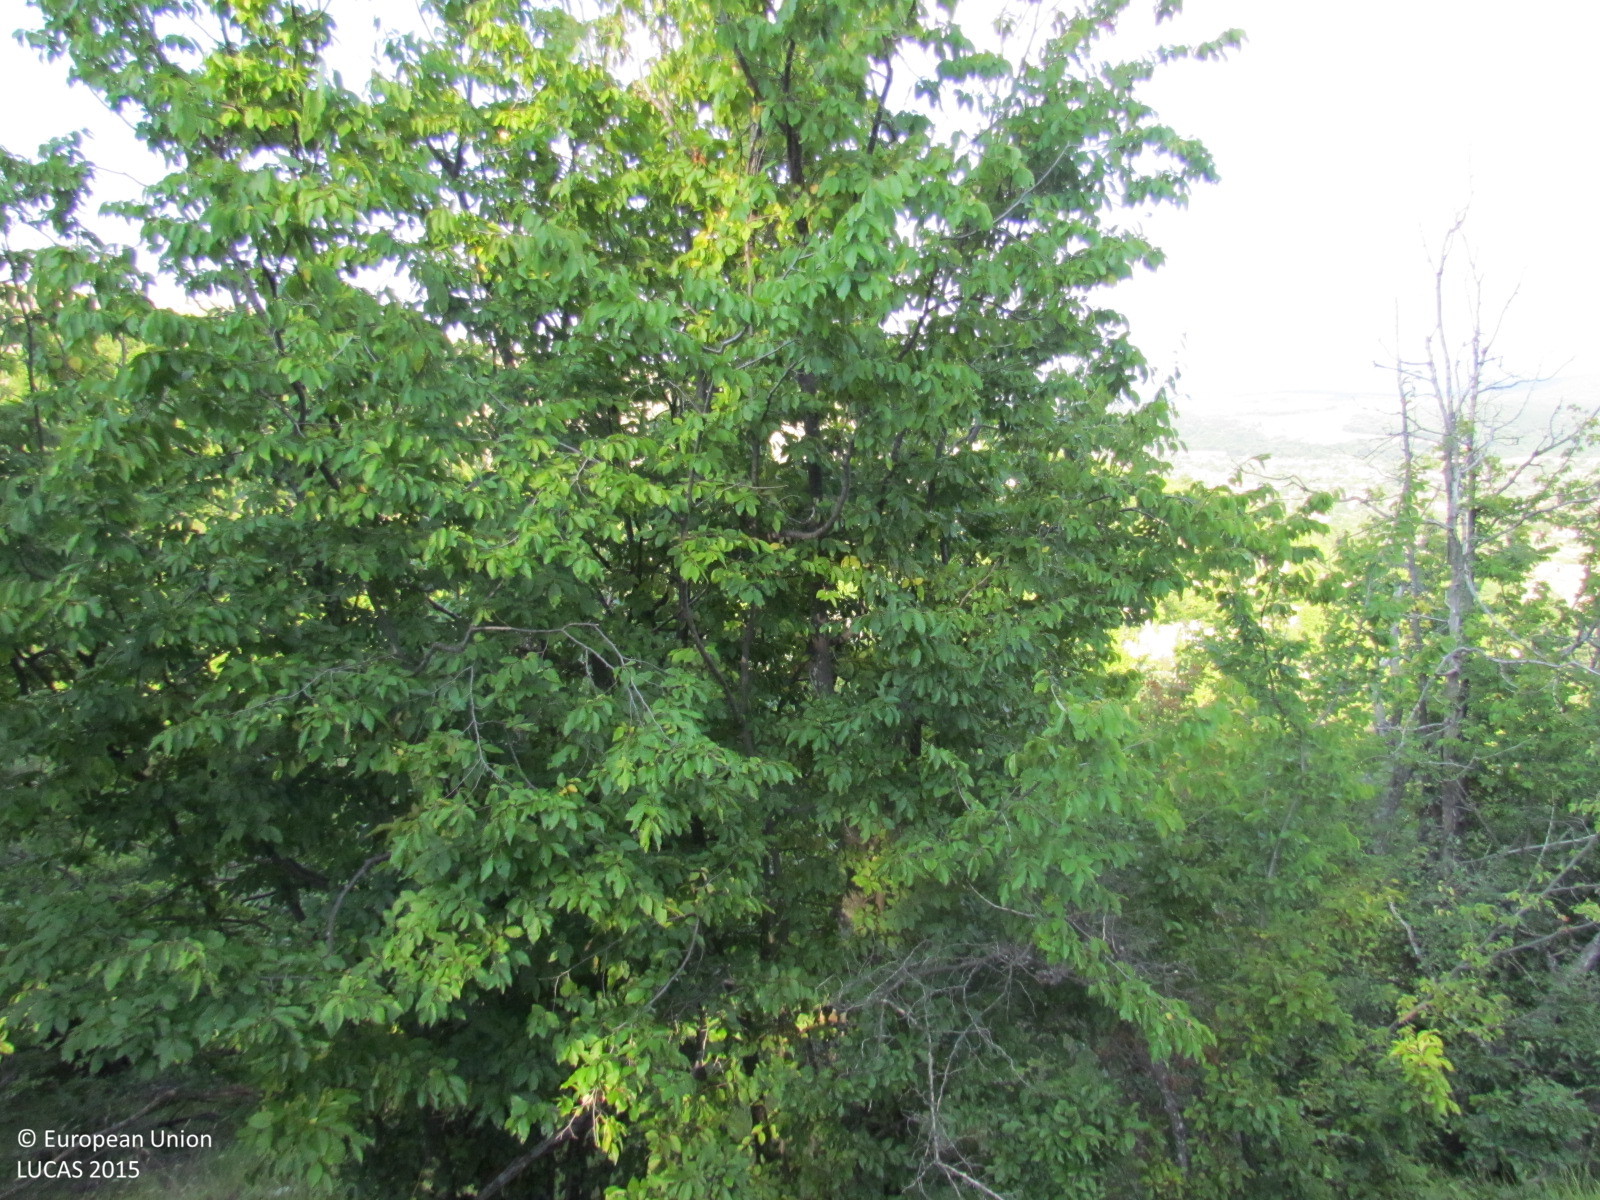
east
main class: Woodland
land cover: Broadleaved woodland
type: mesophytic deciduous forest
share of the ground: 50 - 75 %
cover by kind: broadleaved forest trees 60 %, herbaceous plants 30 %, shrubs 10 %
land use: Forestry
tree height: < 5 m
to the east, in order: Broadleaved woodland; Rivers and streams; Broadleaved woodland; Tracks; Broadleaved woodland
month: July
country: BG
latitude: 42.9173
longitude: 27.5321
